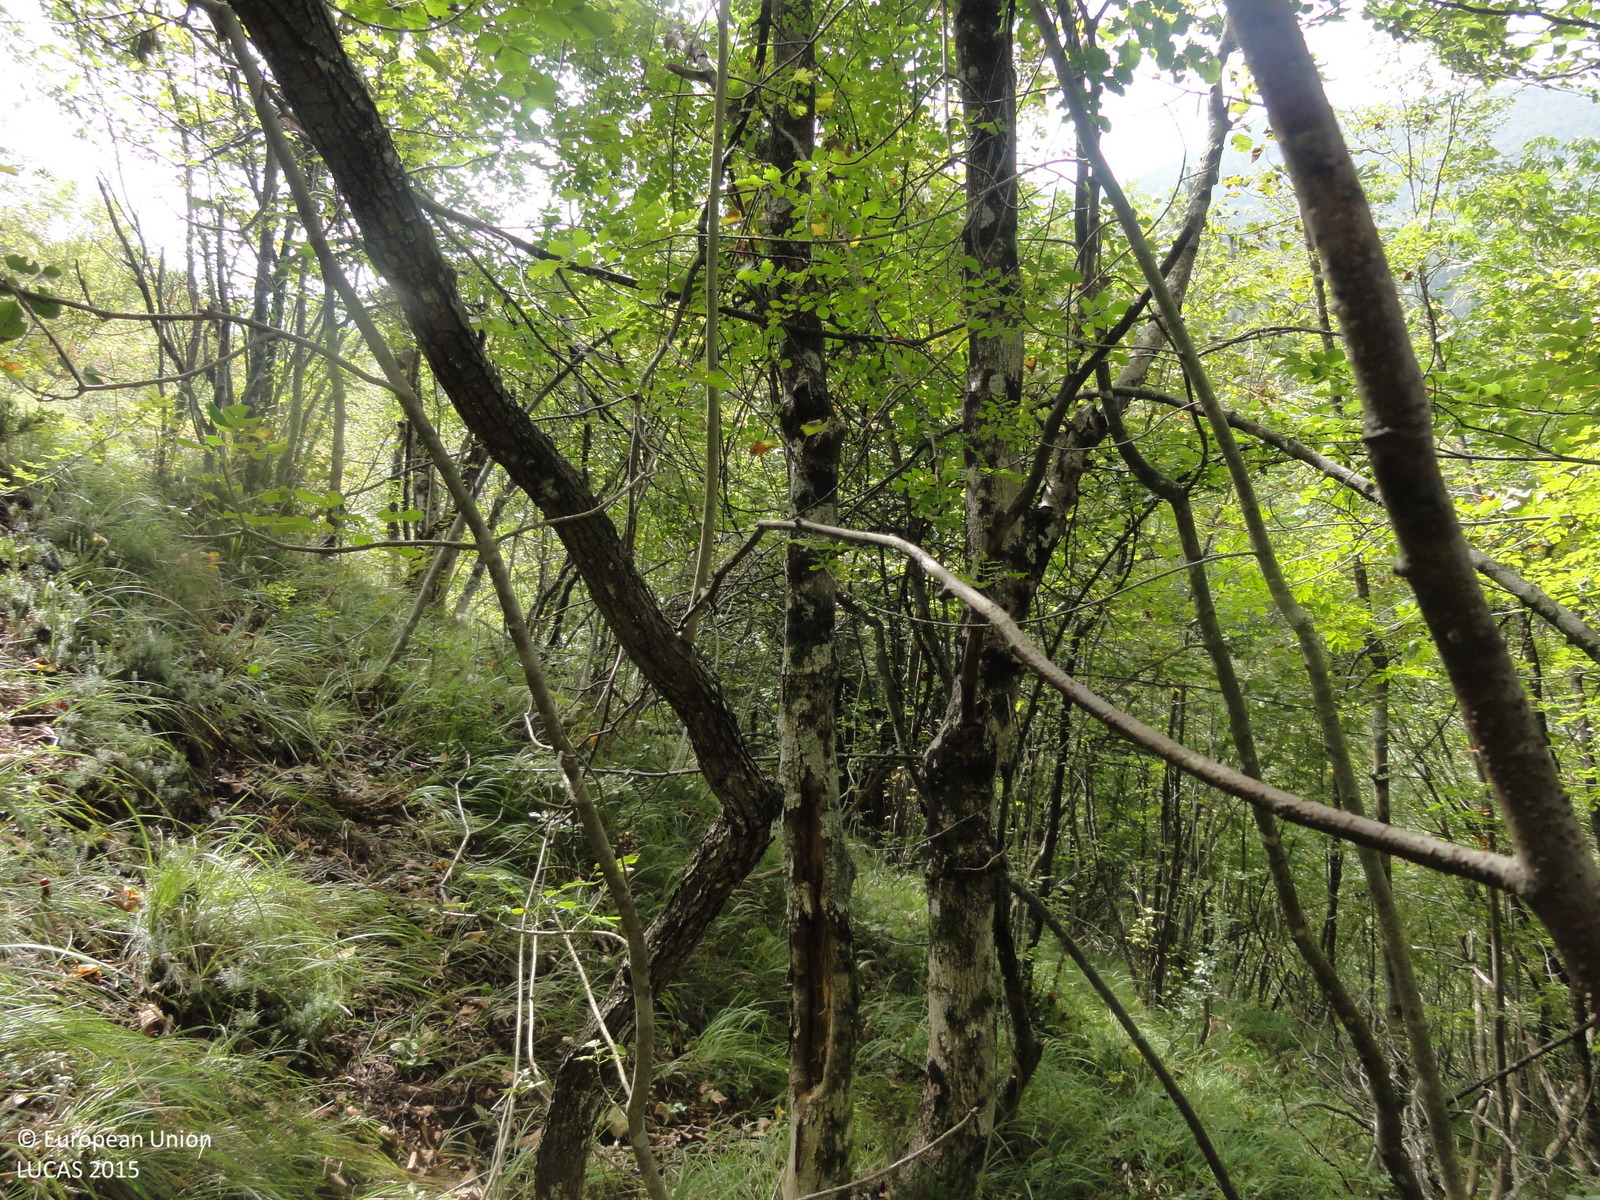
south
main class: Woodland
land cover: Broadleaved woodland
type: beech forest
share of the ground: > 75 %
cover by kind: broadleaved forest trees 75 %, herbaceous plants 15 %, coniferous forest trees 5 %, shrubs 5 %
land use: Forestry
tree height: > 5 m
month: September
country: SI
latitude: 45.5241
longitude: 14.7455
